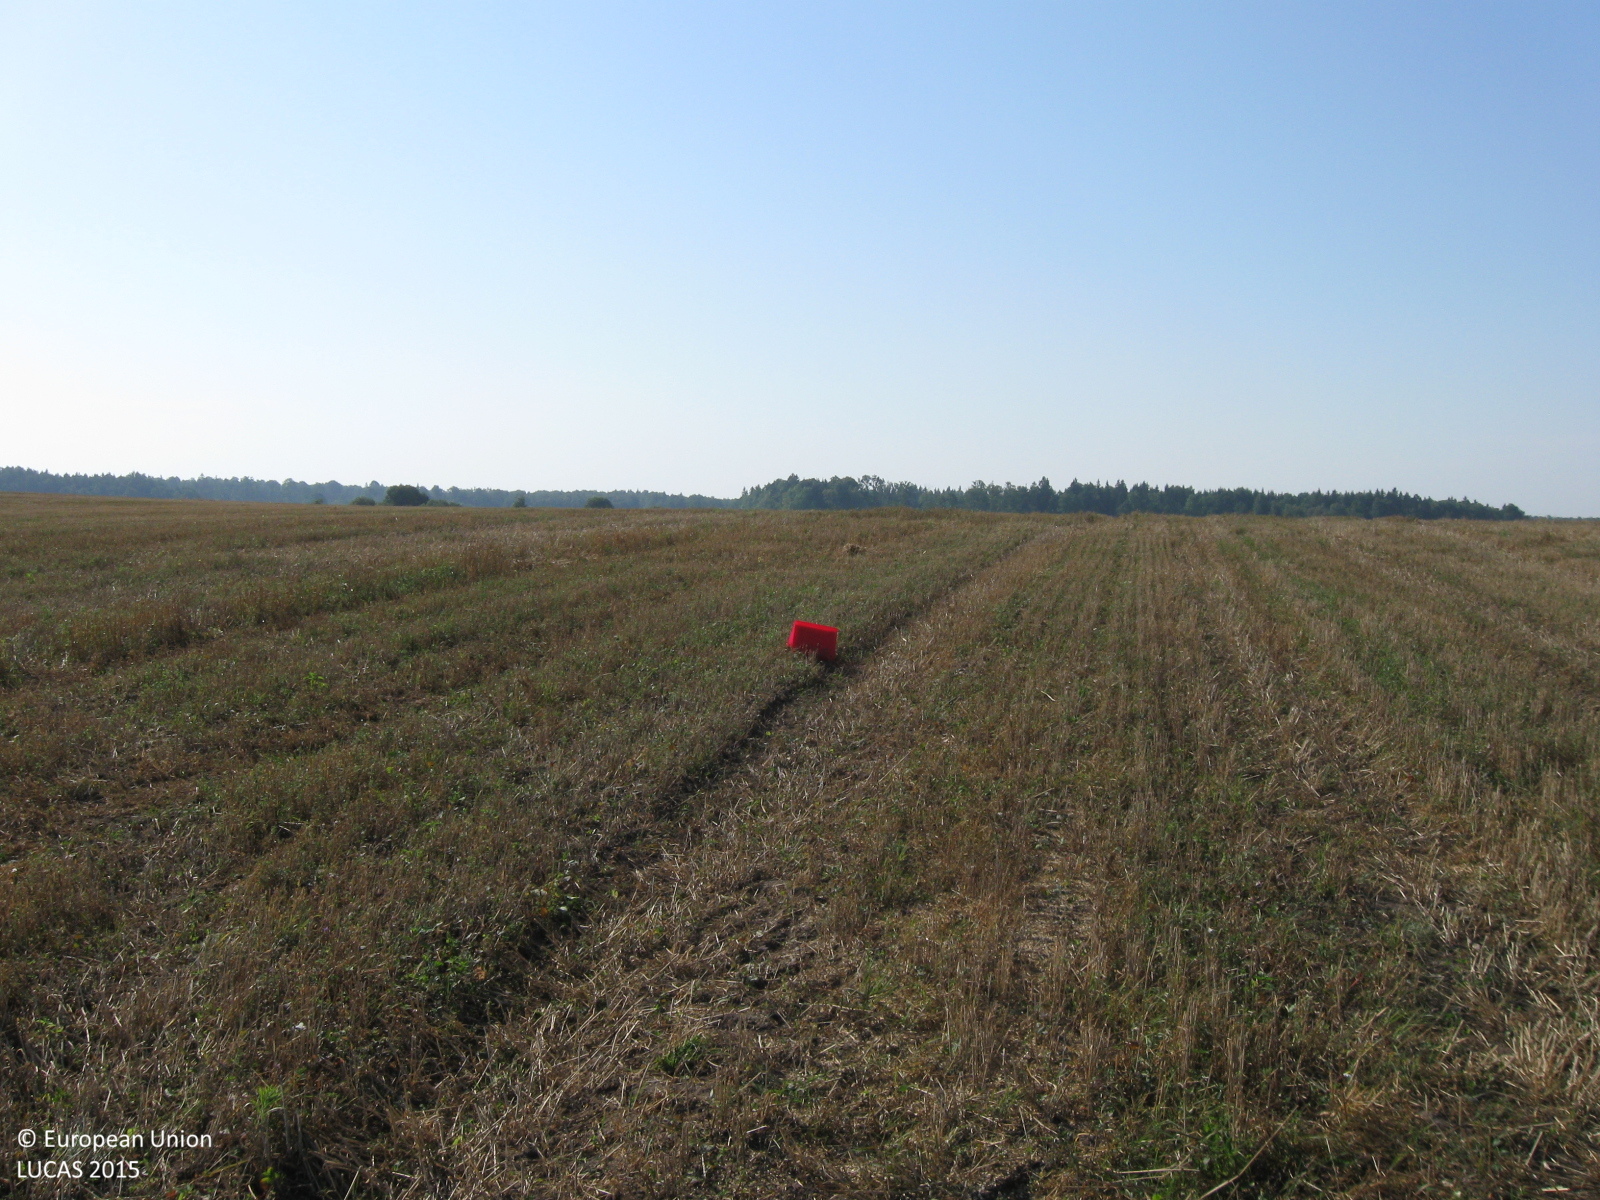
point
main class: Cropland
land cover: Common wheat
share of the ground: > 75 %
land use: Agriculture (excluding fallow land and kitchen gardens)
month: August
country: LT
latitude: 55.5040
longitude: 23.0047
